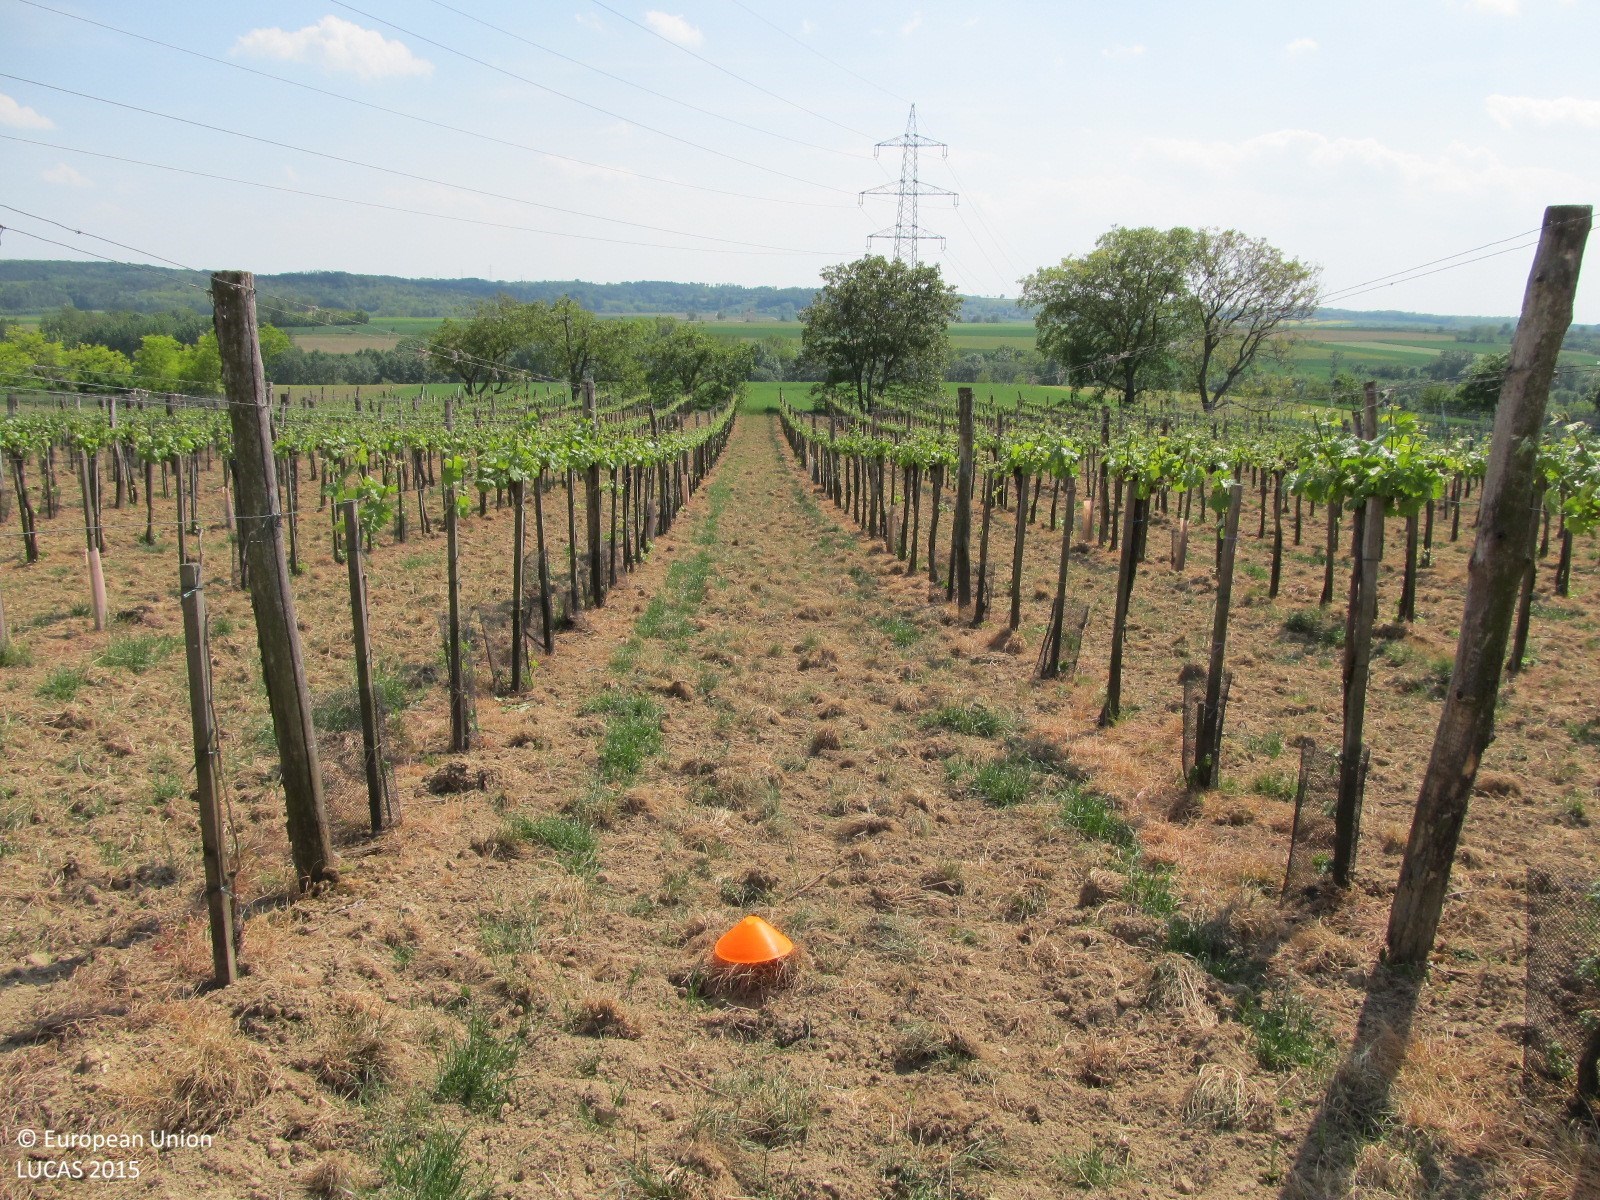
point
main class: Cropland
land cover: Vineyards
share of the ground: 25 - 50 %
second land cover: Spontaneously vegetated surfaces
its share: 50 - 75 %
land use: Agriculture (excluding fallow land and kitchen gardens)
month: May
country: AT
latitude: 48.5363
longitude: 15.8681
